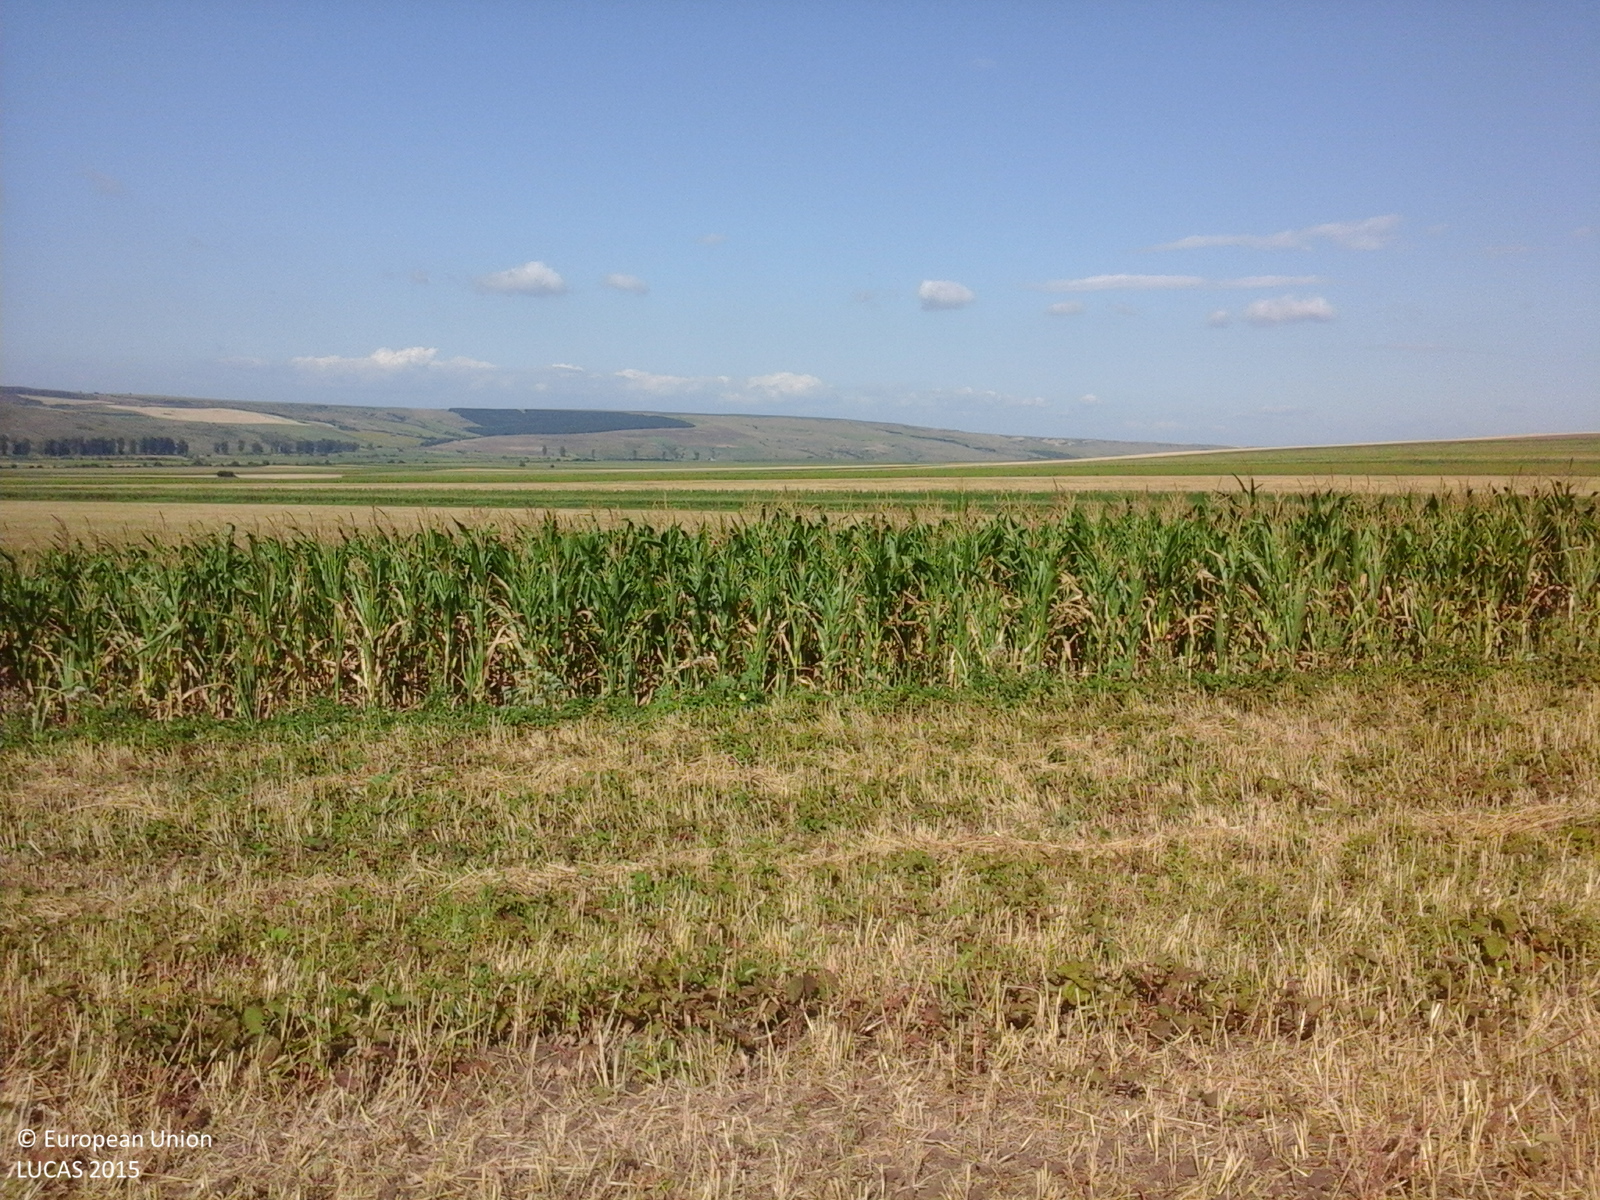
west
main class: Cropland
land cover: Common wheat
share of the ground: 50 - 75 %
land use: Agriculture (excluding fallow land and kitchen gardens)
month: July
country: RO
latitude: 46.1219
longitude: 27.7539
